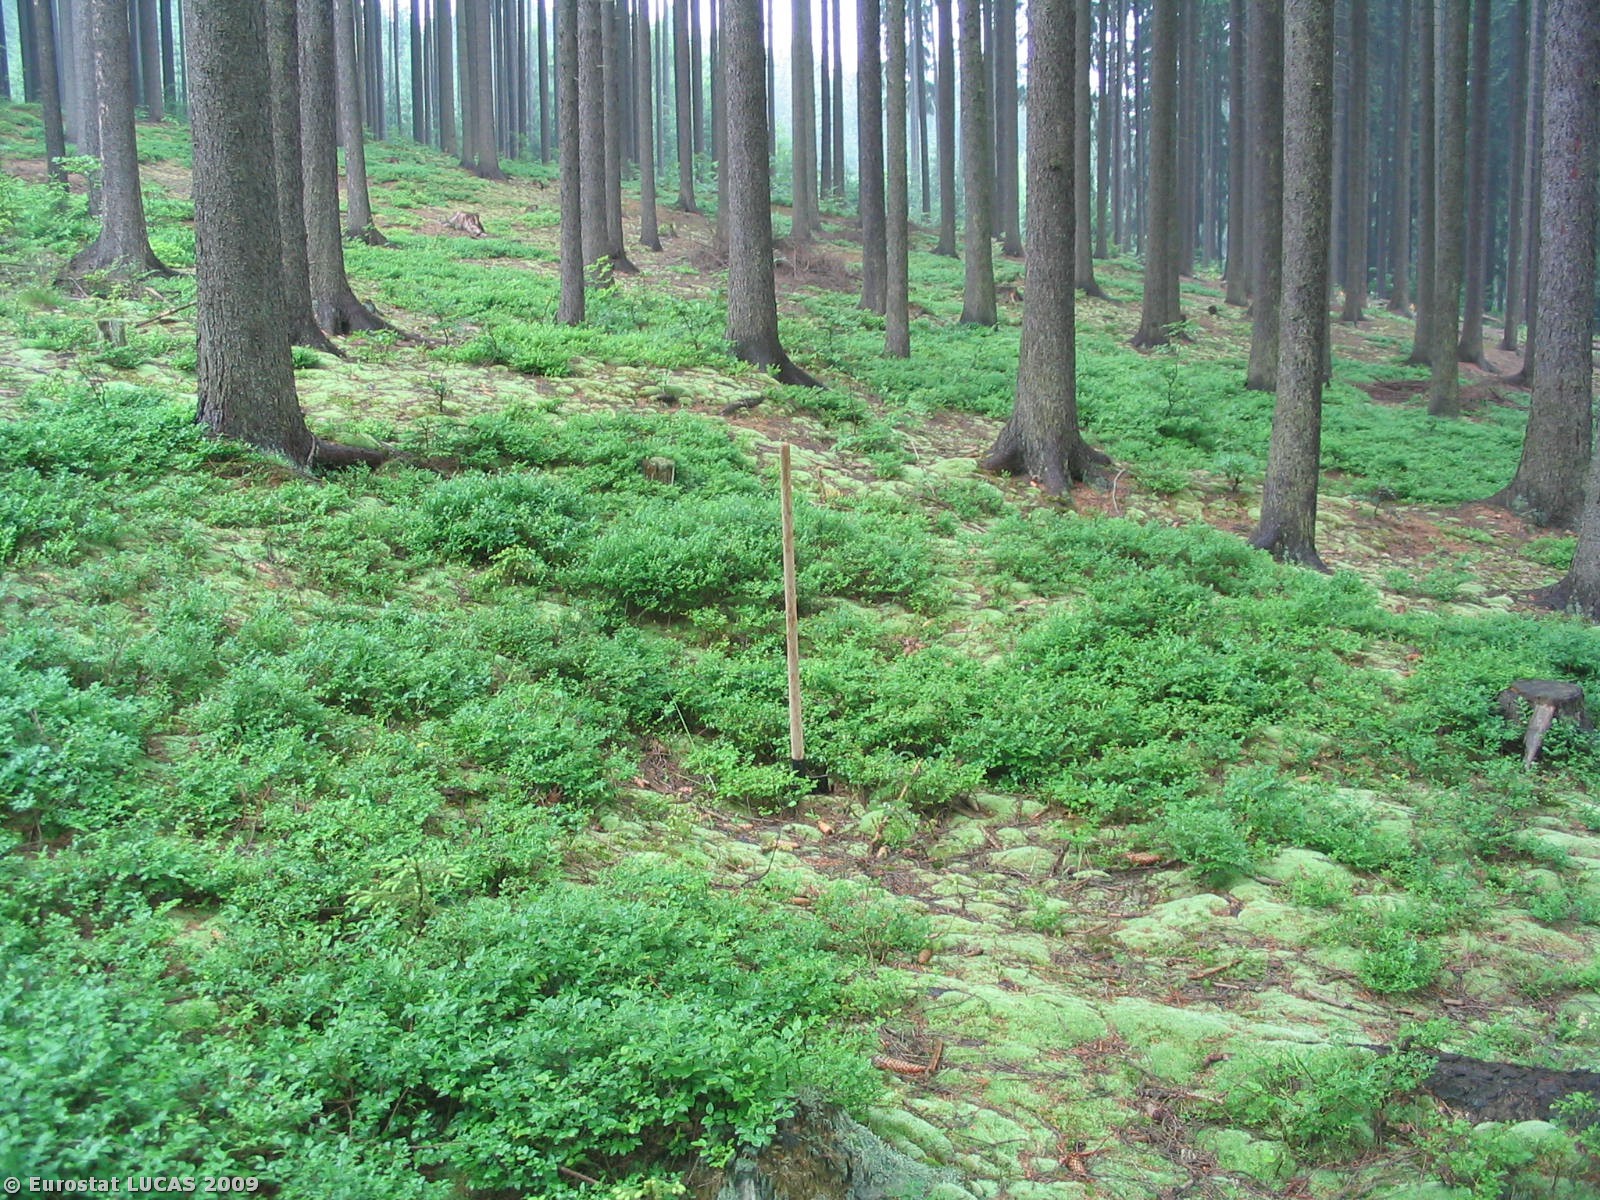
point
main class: Woodland
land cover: Coniferous woodland
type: hemiboreal forest and nemoral coniferous forest and mixed broadleaved-coniferous forest
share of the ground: > 75 %
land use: Forestry
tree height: > 5 m
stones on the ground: < 10 %
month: June
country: CZ
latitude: 49.5049
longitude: 18.7339
